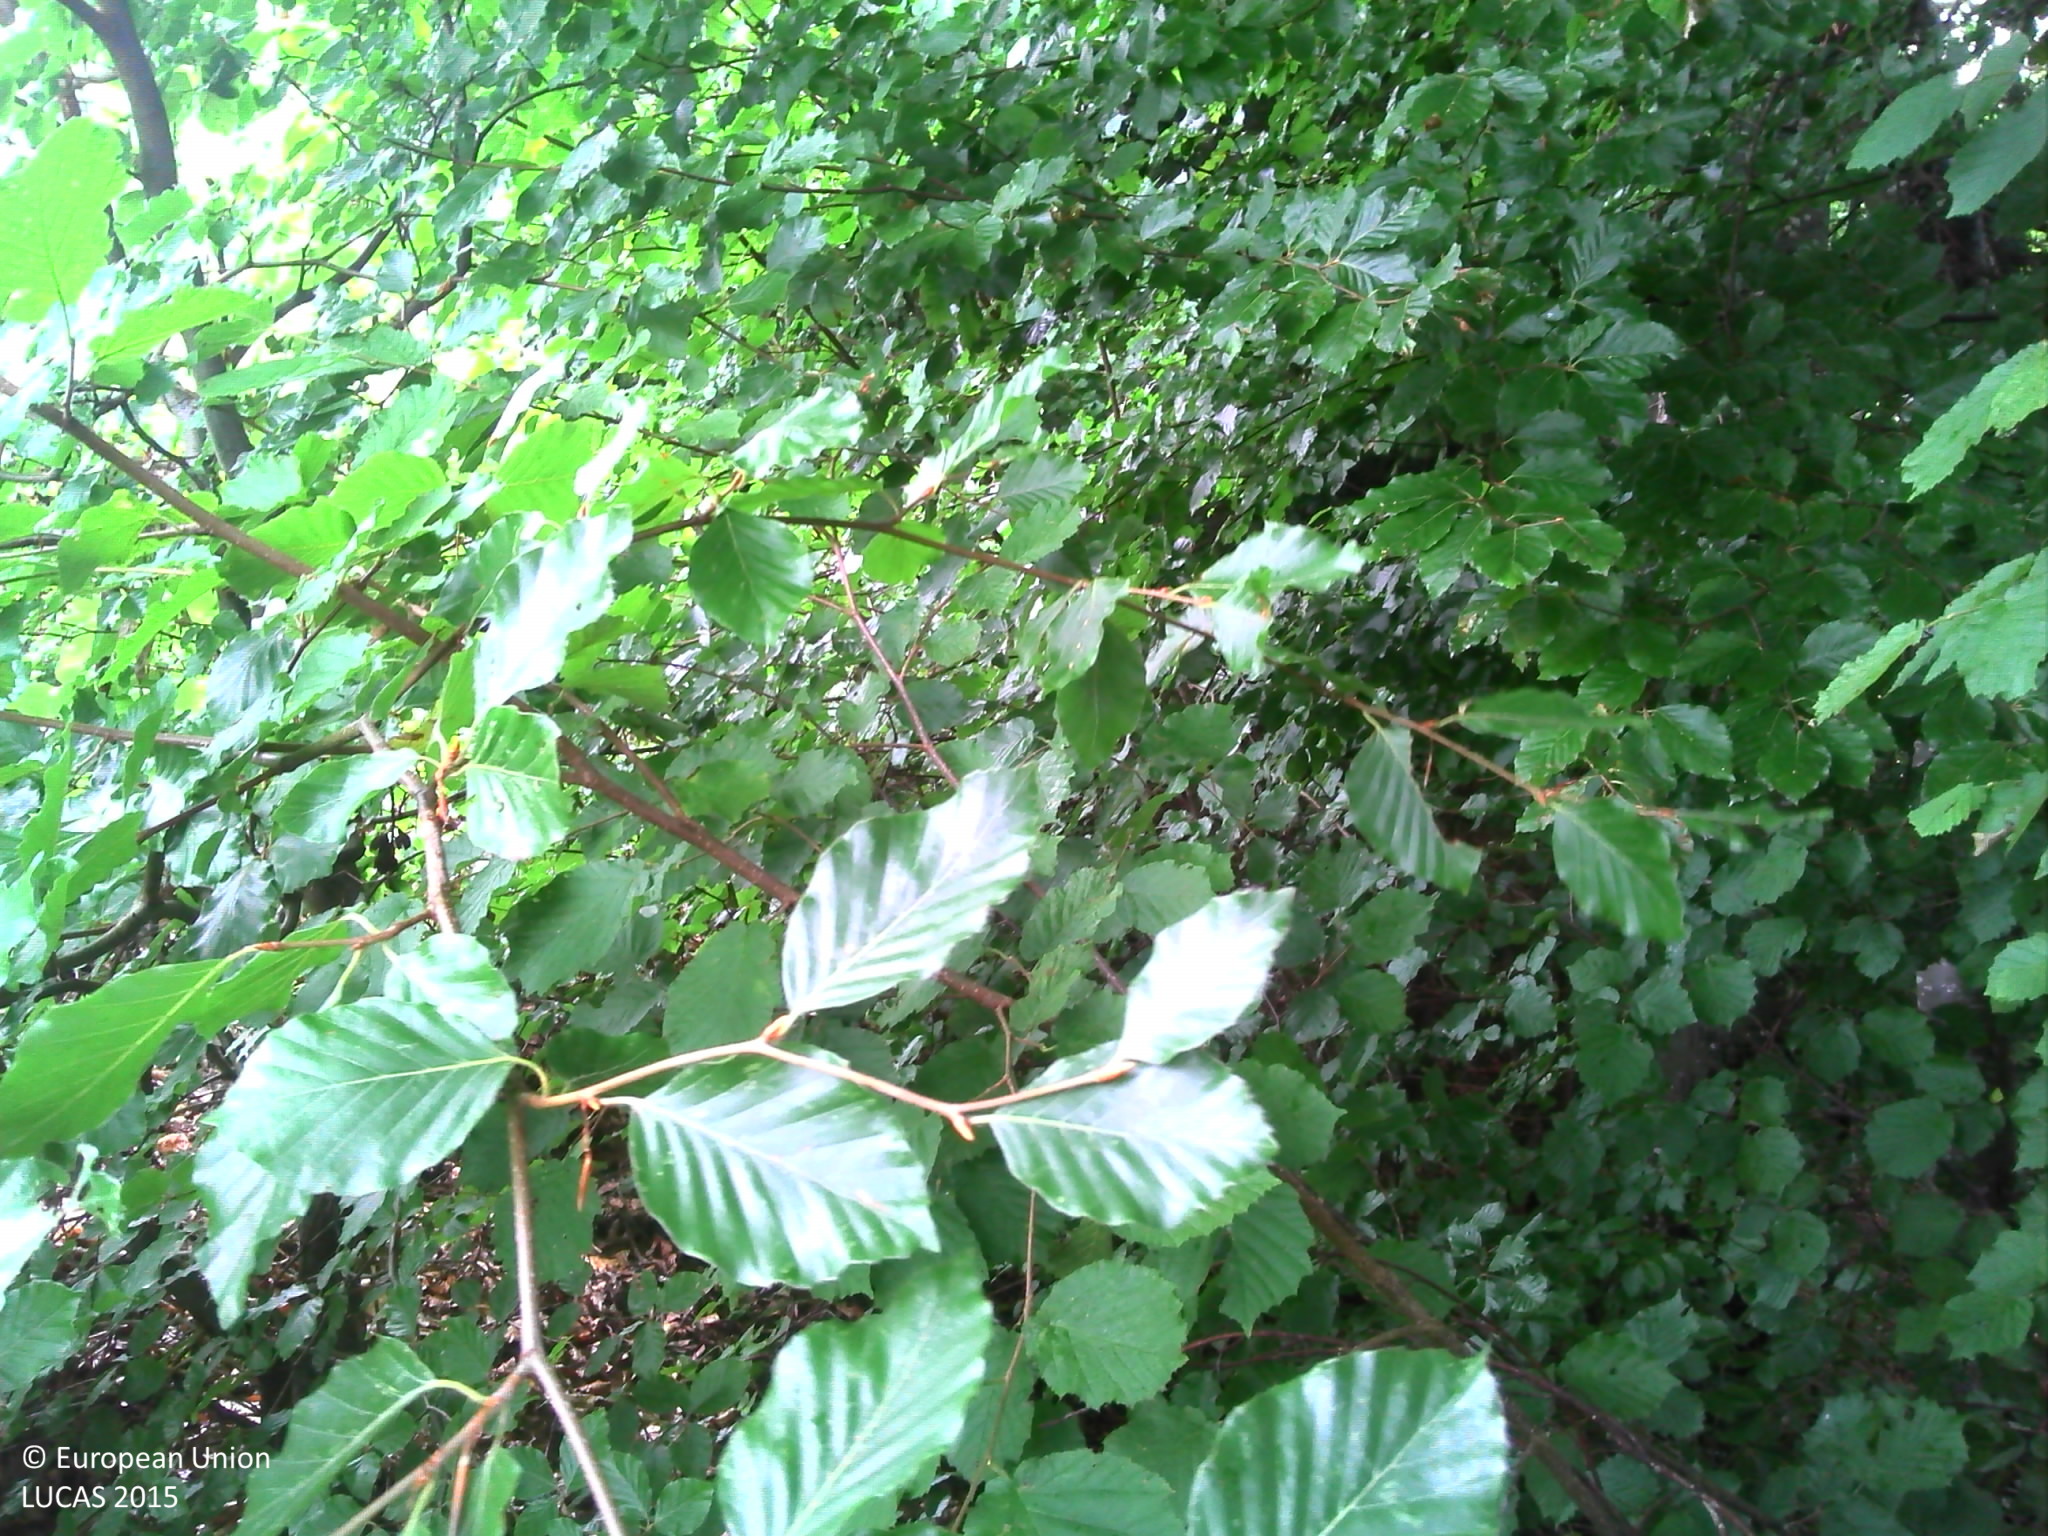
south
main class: Woodland
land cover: Broadleaved woodland
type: beech forest
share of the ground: > 75 %
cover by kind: broadleaved forest trees 70 %, coniferous forest trees 15 %, herbaceous plants 10 %, lichens and mosses 5 %
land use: Forestry
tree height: > 5 m
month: July
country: FR
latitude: 46.0526
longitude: 6.2943
